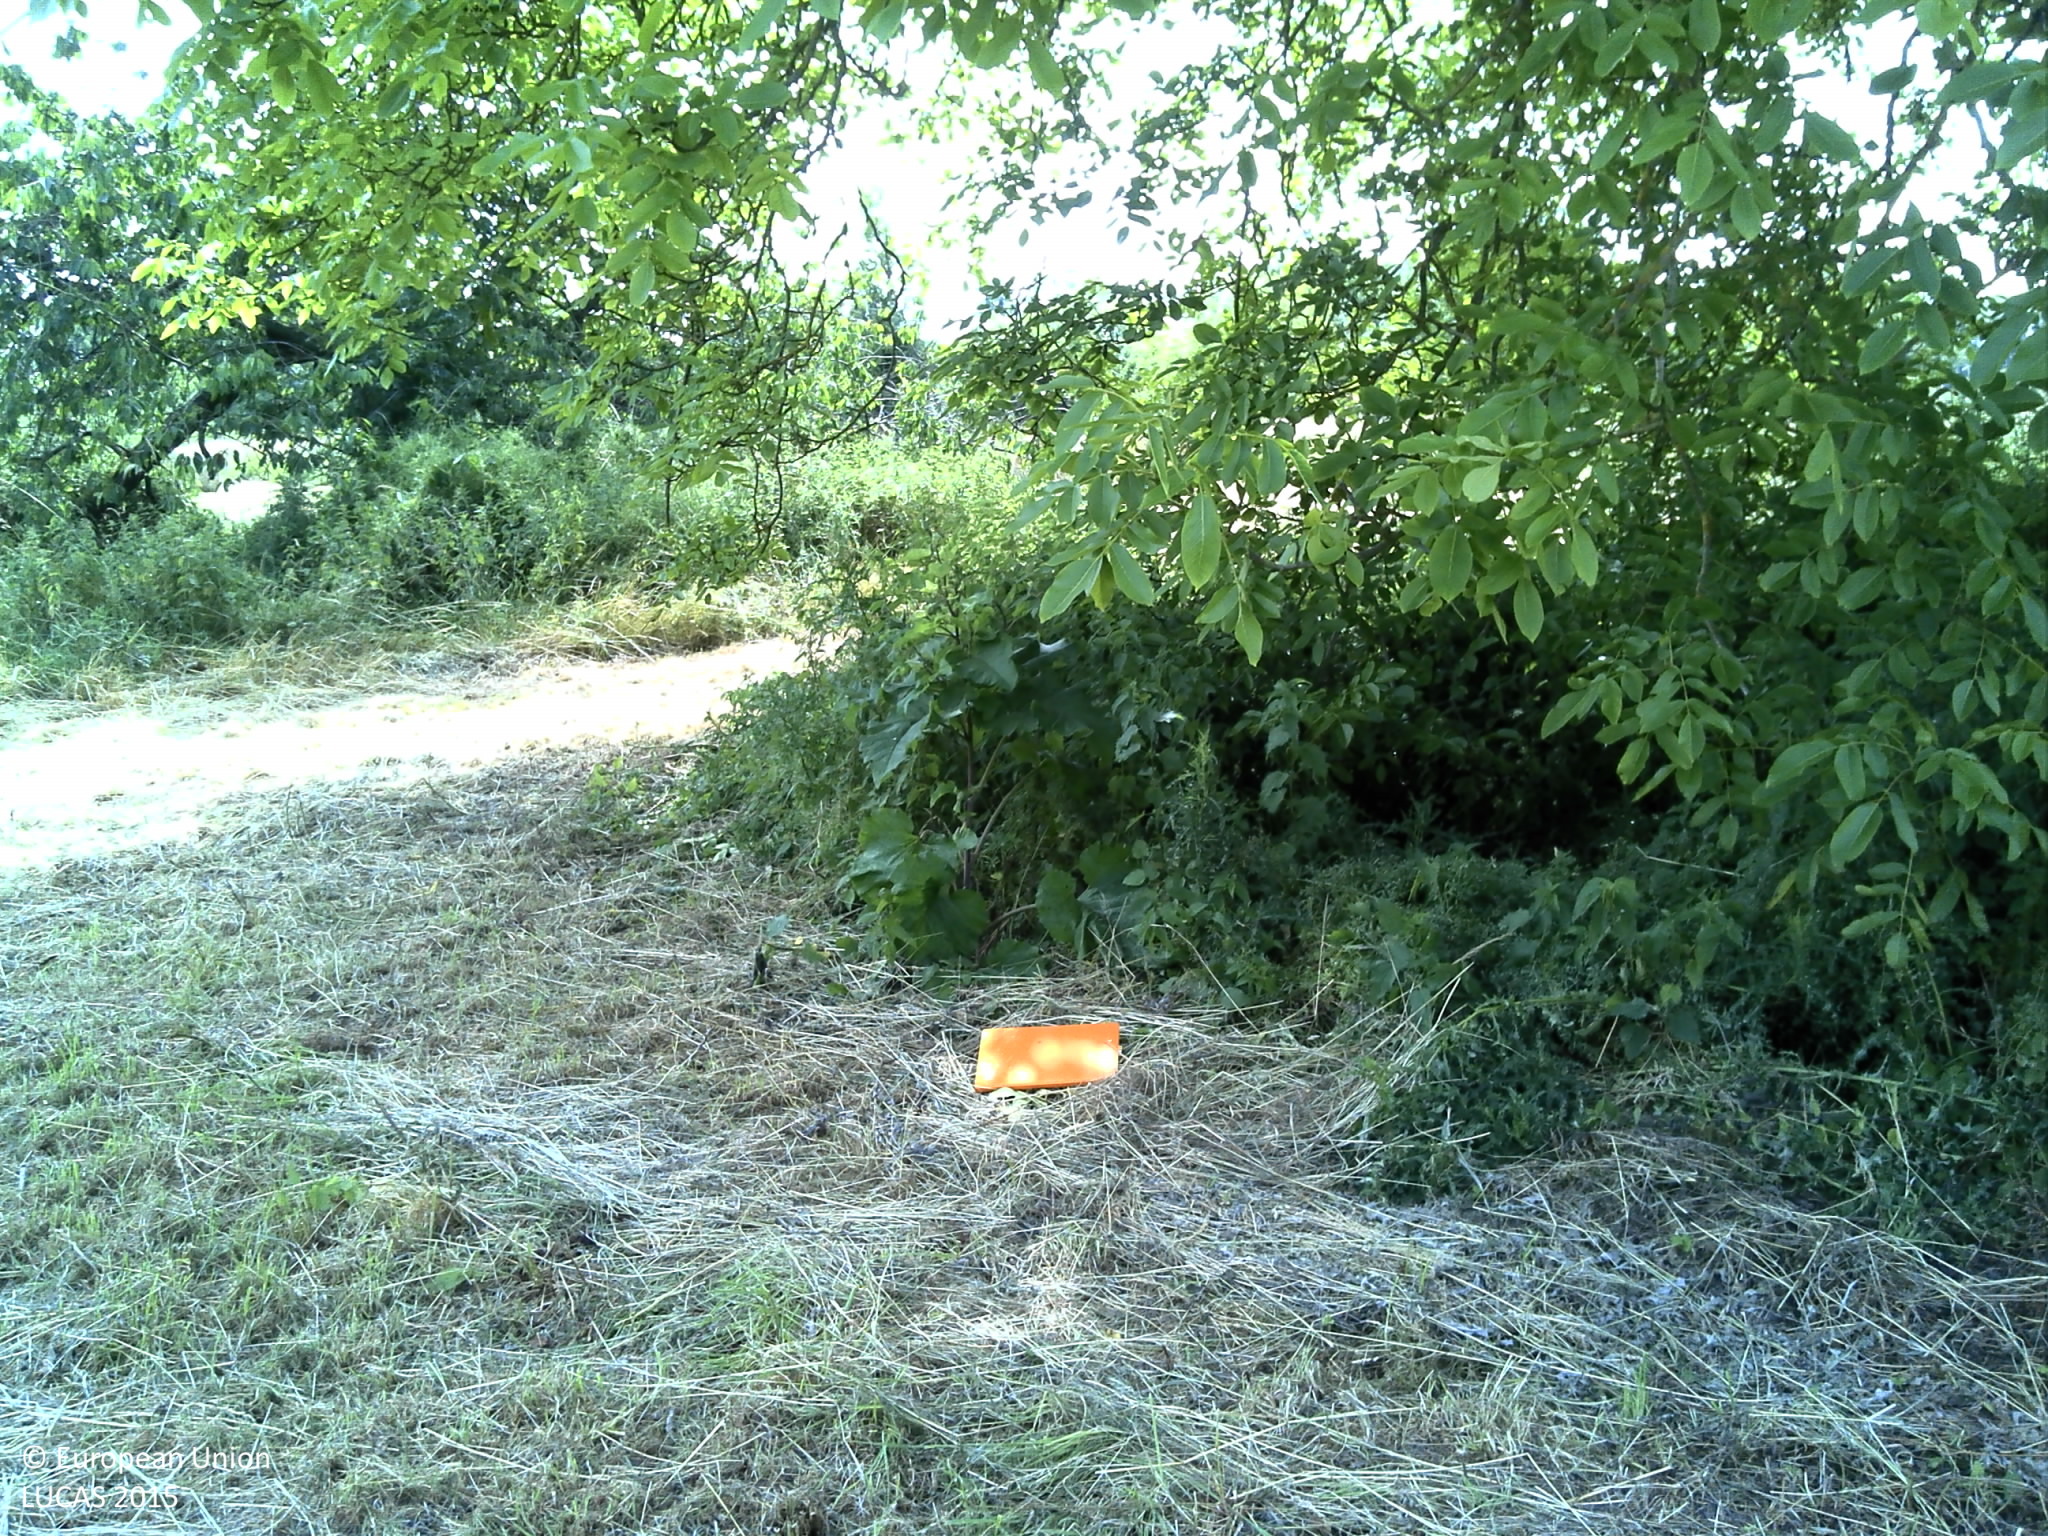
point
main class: Cropland
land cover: Nuts trees
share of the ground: 50 - 75 %
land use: Agriculture (excluding fallow land and kitchen gardens)
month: June
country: FR
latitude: 49.3227
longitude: 1.0215
